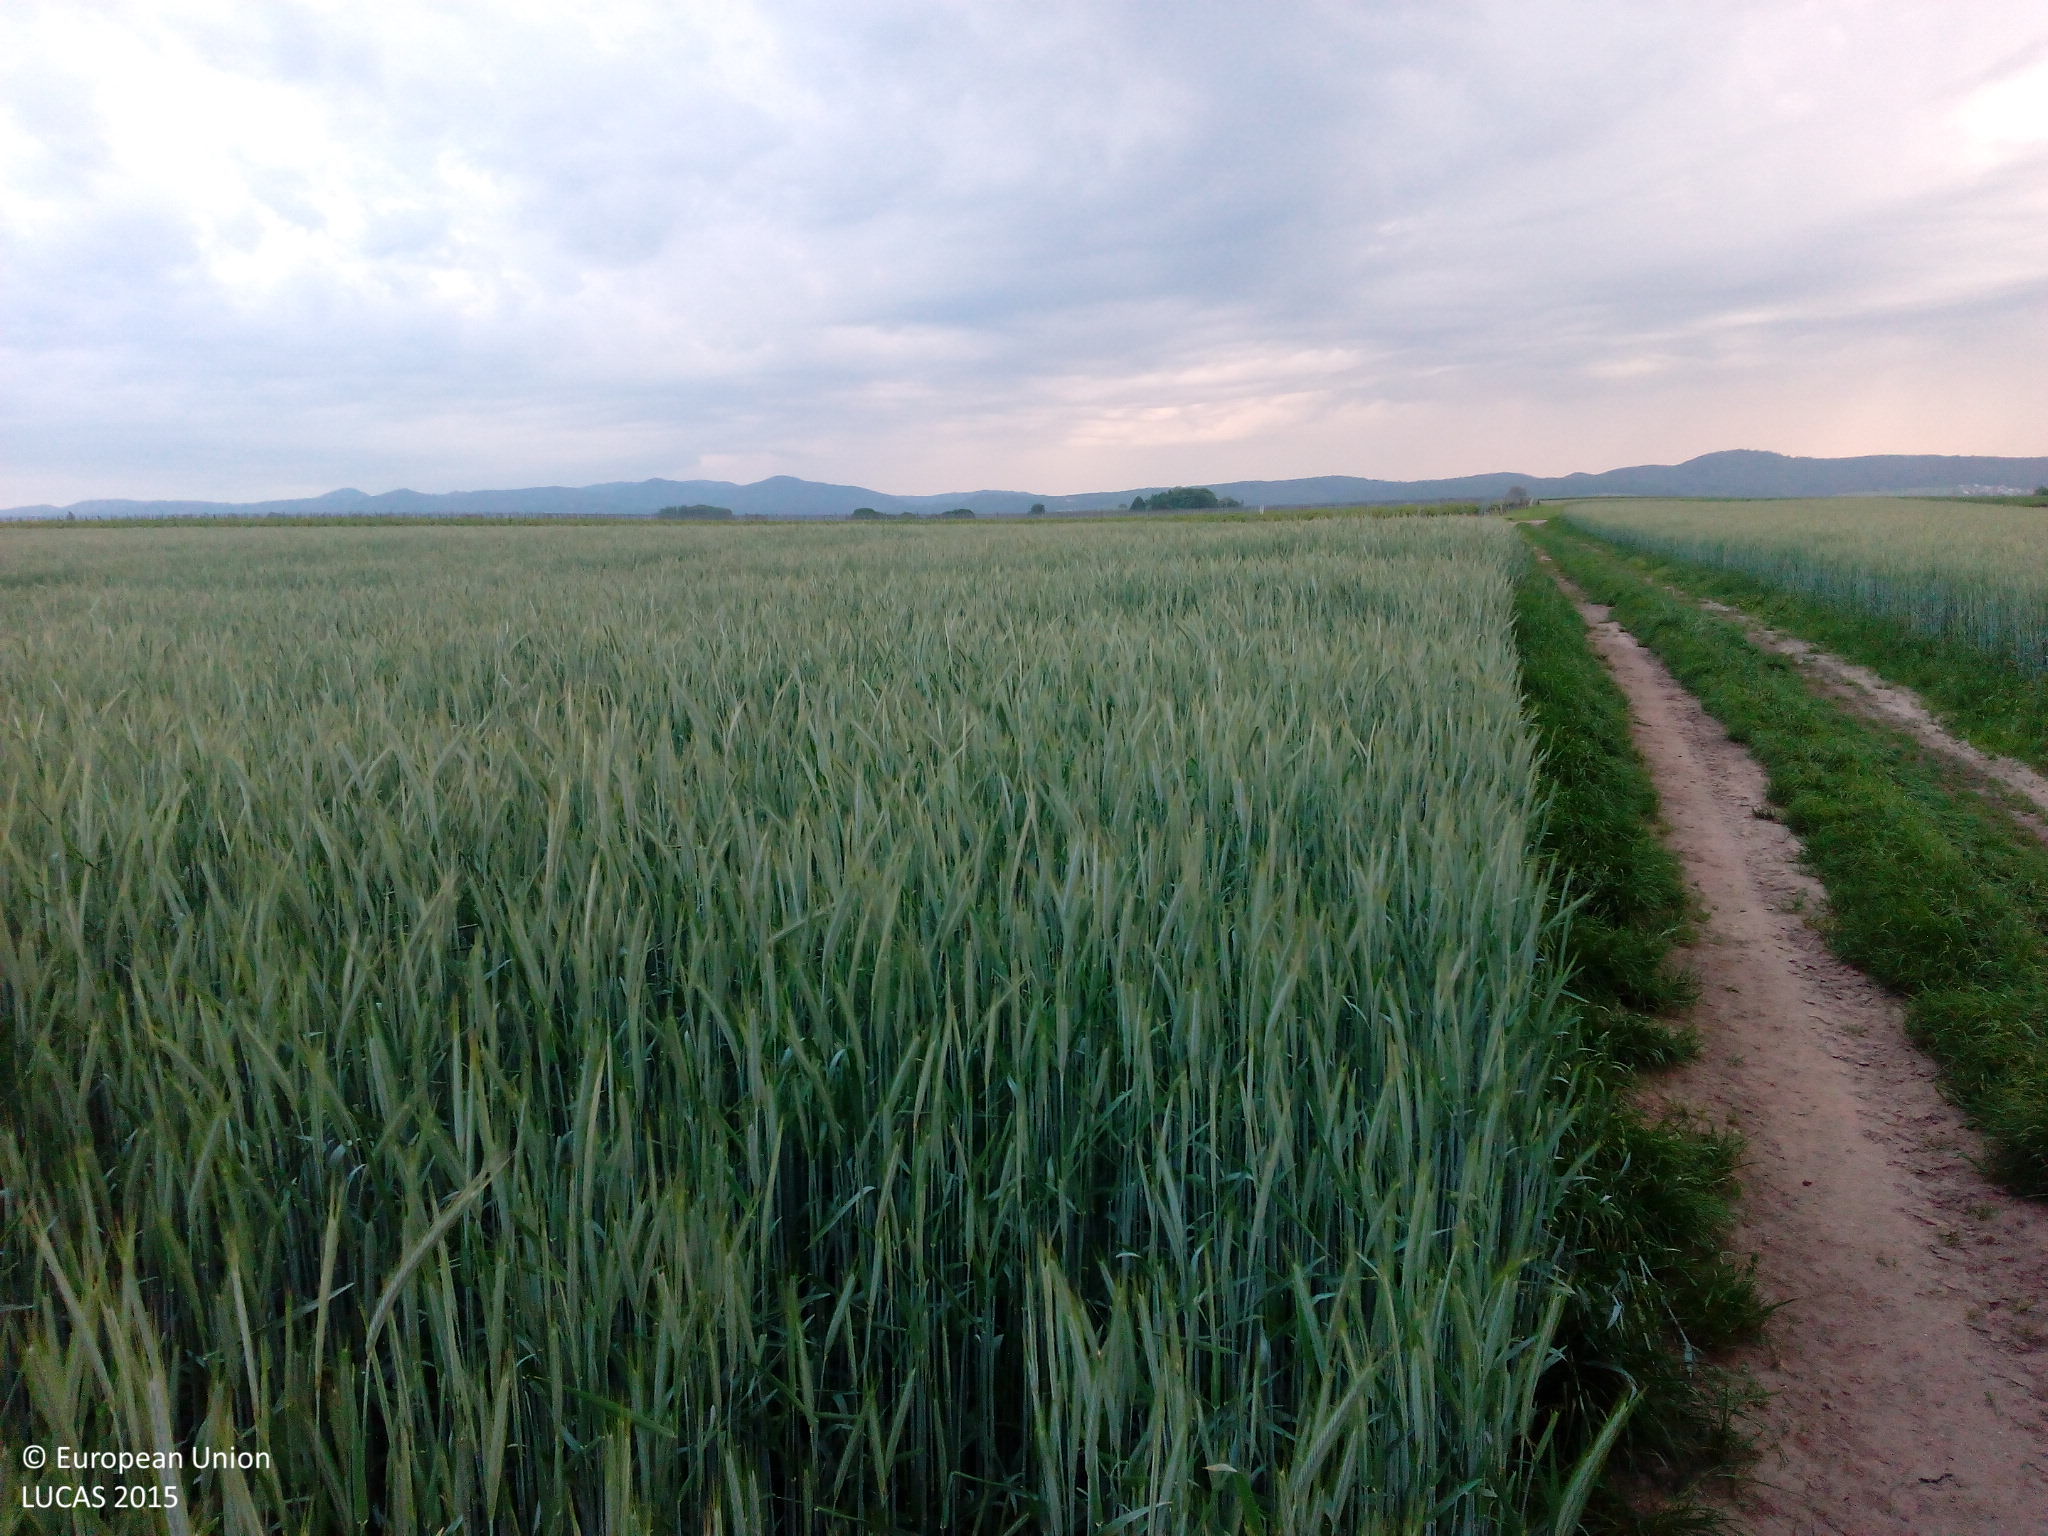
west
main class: Cropland
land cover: Rye
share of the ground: > 75 %
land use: Agriculture (excluding fallow land and kitchen gardens)
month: May
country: DE
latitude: 49.1065
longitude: 8.0692
